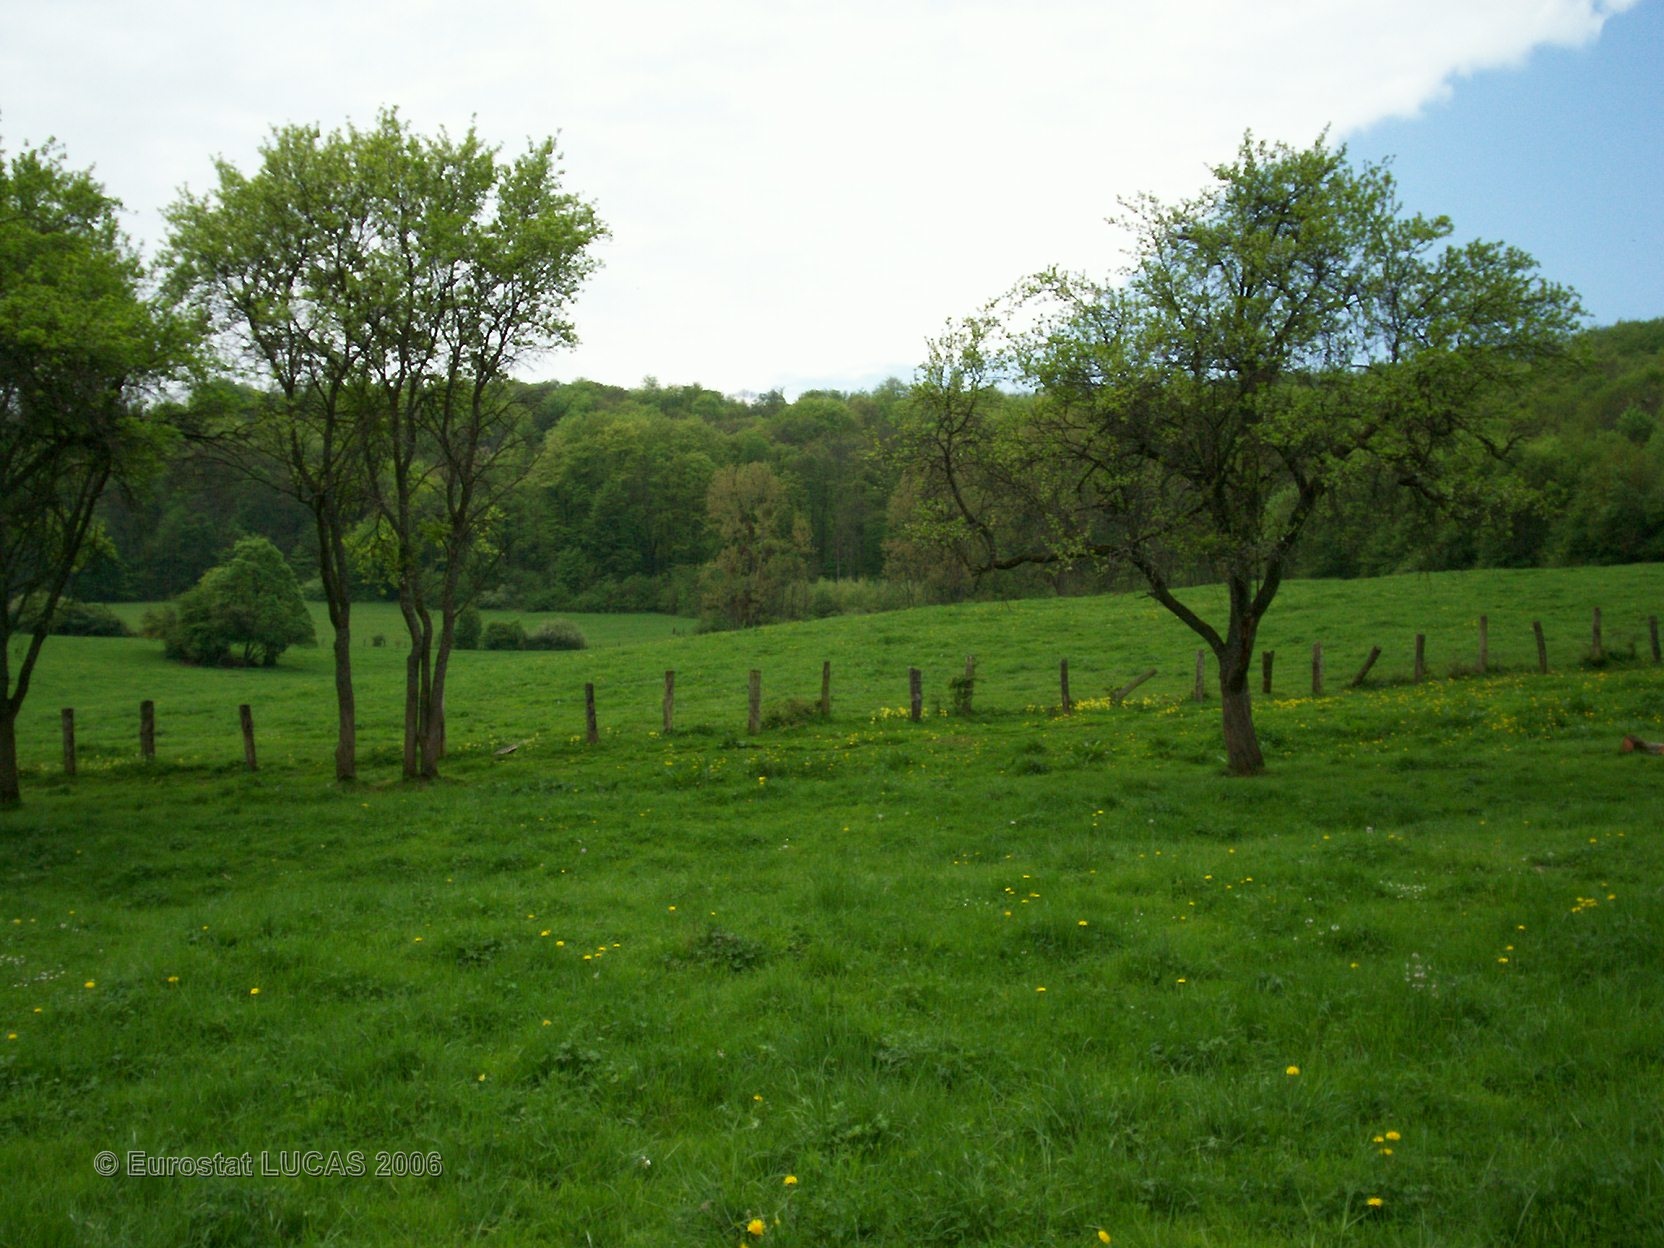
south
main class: Grassland
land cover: Grassland without tree/shrub cover
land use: Agriculture (excluding fallow land and kitchen gardens)
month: May
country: FR
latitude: 48.4387
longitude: 5.9854
